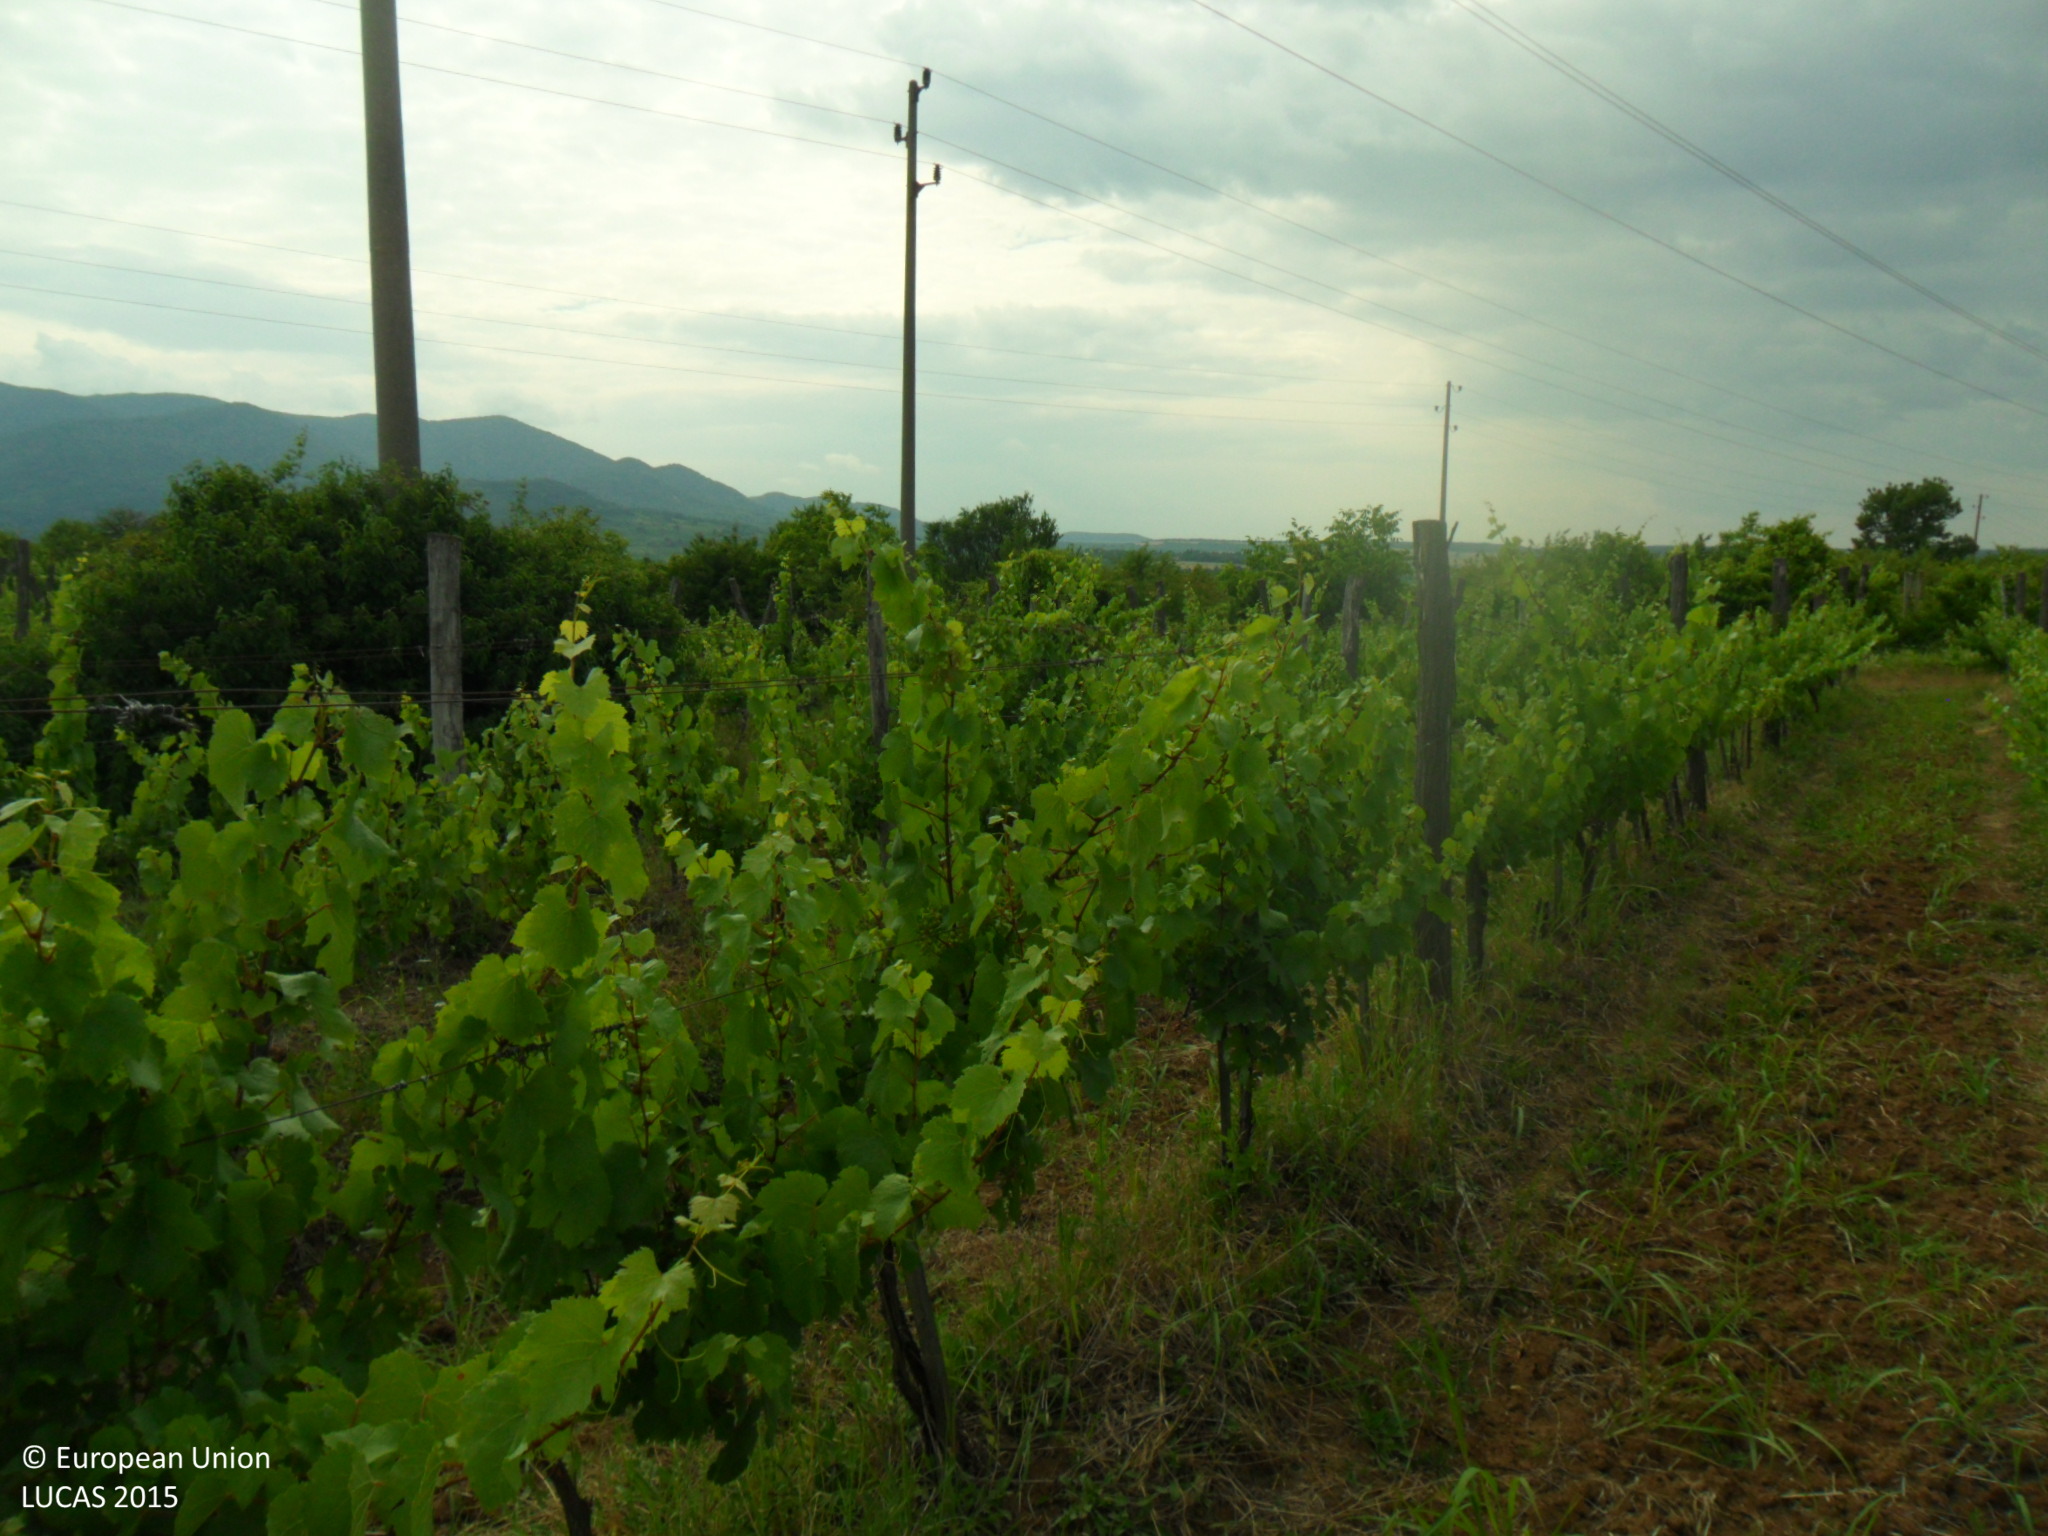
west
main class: Cropland
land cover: Vineyards
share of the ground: 25 - 50 %
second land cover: Spontaneously vegetated surfaces
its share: > 75 %
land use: Agriculture (excluding fallow land and kitchen gardens)
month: June
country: BG
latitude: 43.1456
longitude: 26.8436
